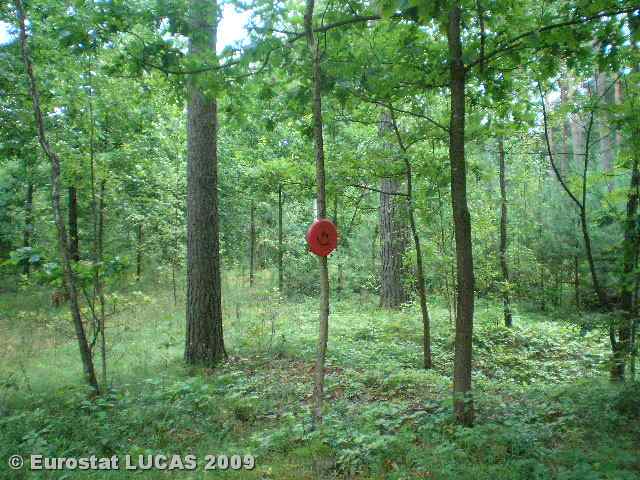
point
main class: Woodland
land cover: Mixed woodland
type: hemiboreal forest and nemoral coniferous forest and mixed broadleaved-coniferous forest
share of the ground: > 75 %
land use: Forestry
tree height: > 5 m
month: July
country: LT
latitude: 54.8598
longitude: 25.4387
